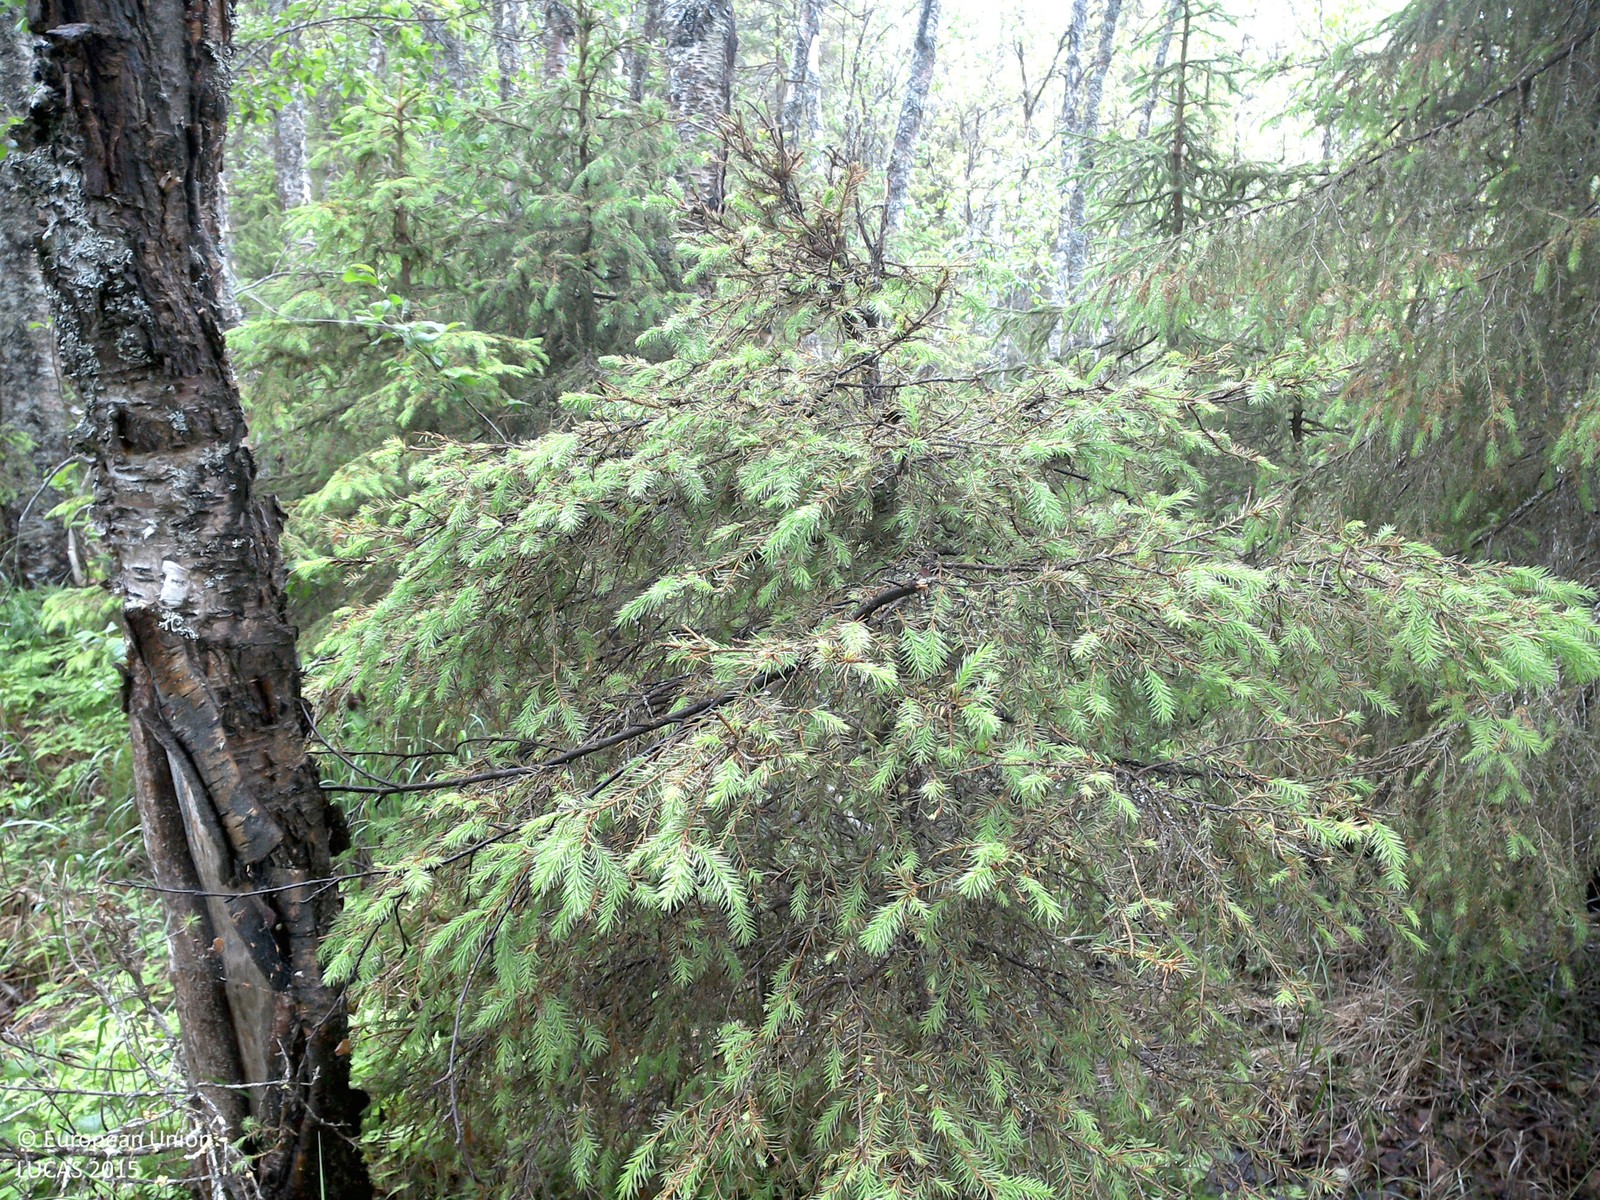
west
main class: Woodland
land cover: Other mixed woodland
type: boreal forest
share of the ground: 25 - 50 %
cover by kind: lichens and mosses 35 %, broadleaved forest trees 30 %, herbaceous plants 25 %, coniferous forest trees 10 %
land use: Forestry
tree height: > 5 m
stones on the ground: < 10 %
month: July
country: SE
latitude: 67.0145
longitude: 23.5860
